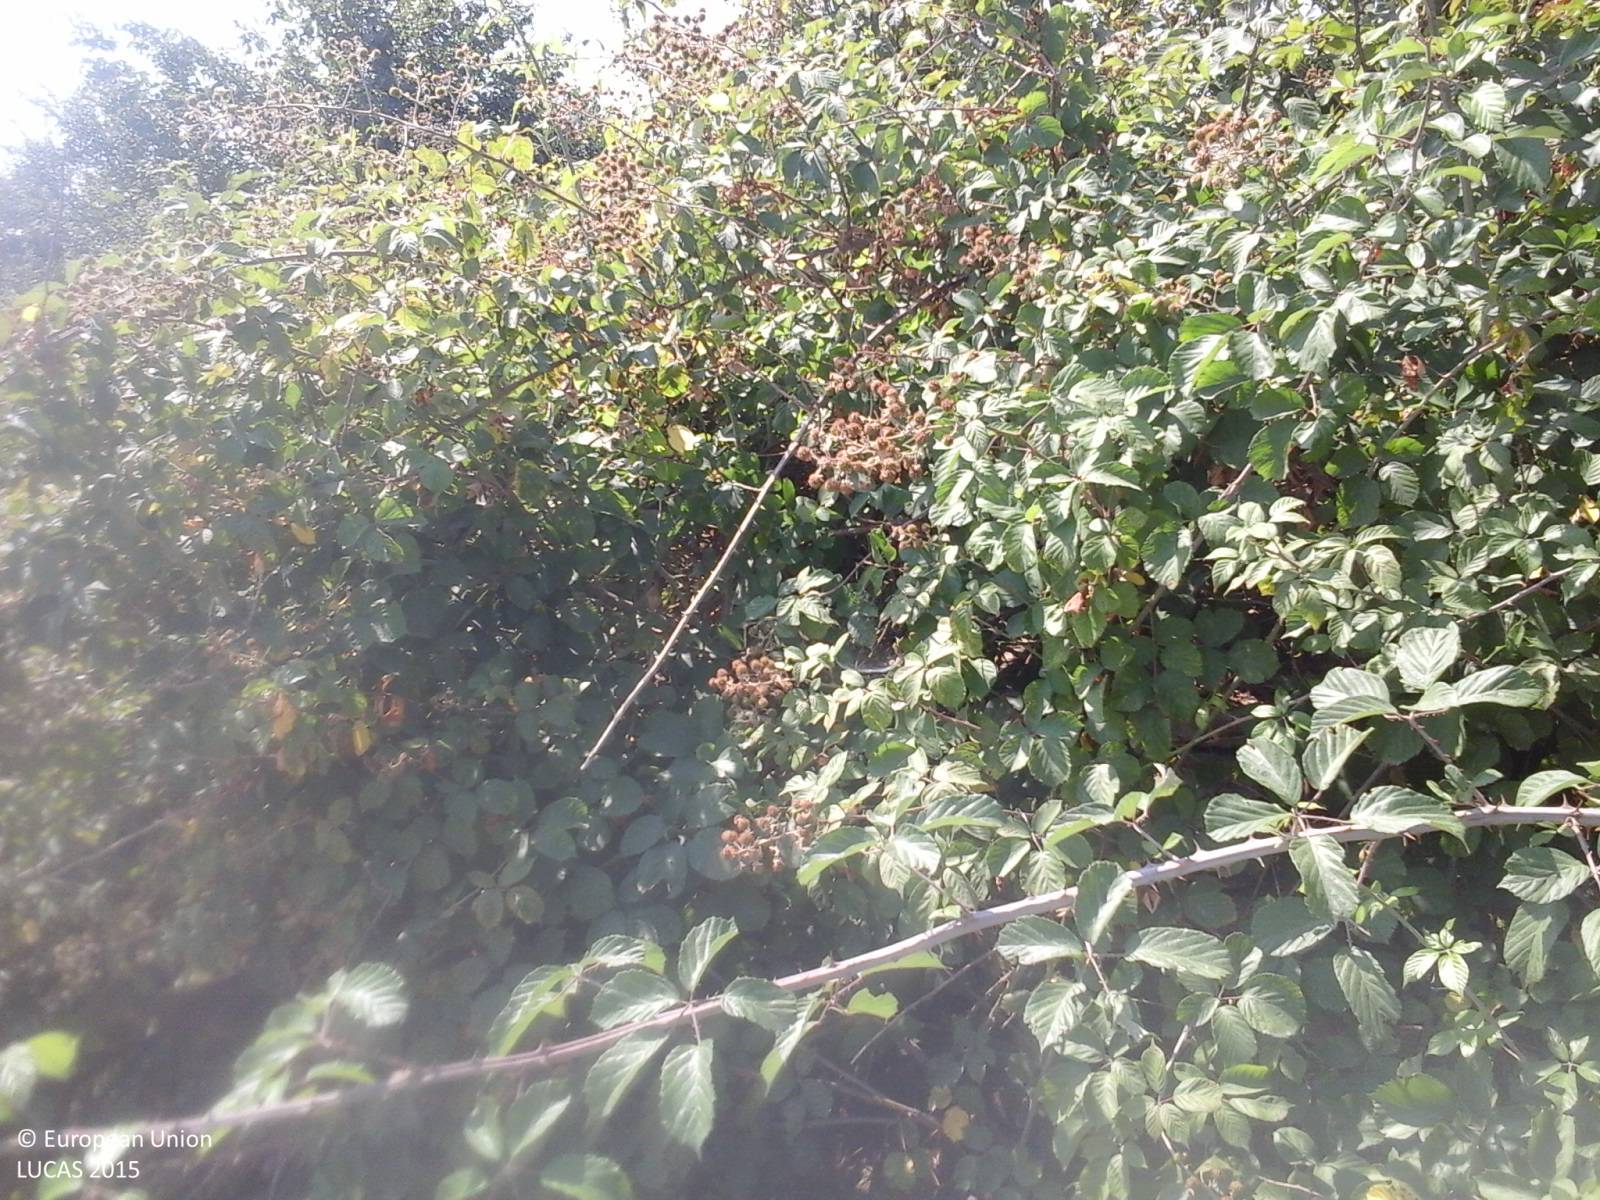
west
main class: Shrubland
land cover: Shrubland with sparse tree cover
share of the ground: 50 - 75 %
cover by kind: shrubs 95 %, broadleaved forest trees 5 %
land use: Abandoned areas
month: July
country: IT
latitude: 43.3048
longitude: 11.8808
